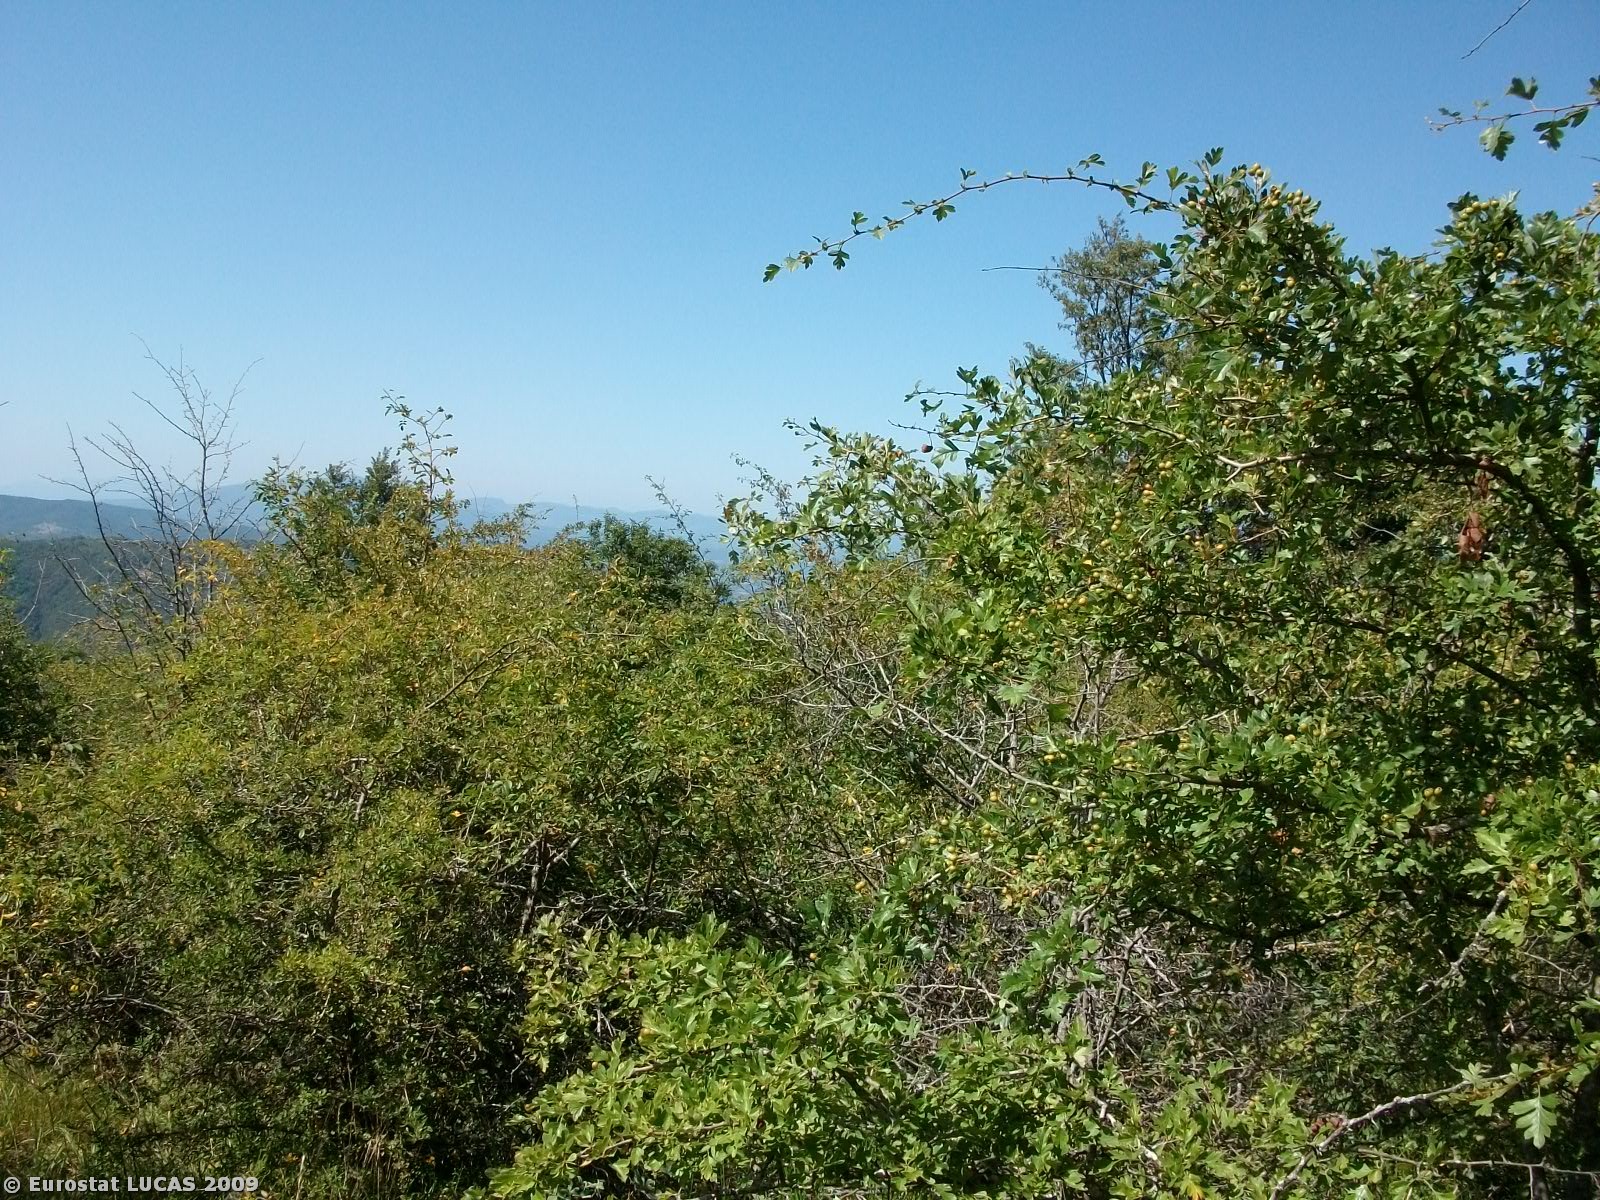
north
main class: Shrubland
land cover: Shrubland with sparse tree cover
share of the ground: > 75 %
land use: Nature reserves
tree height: > 5 m
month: July
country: IT
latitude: 43.4097
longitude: 12.0566
